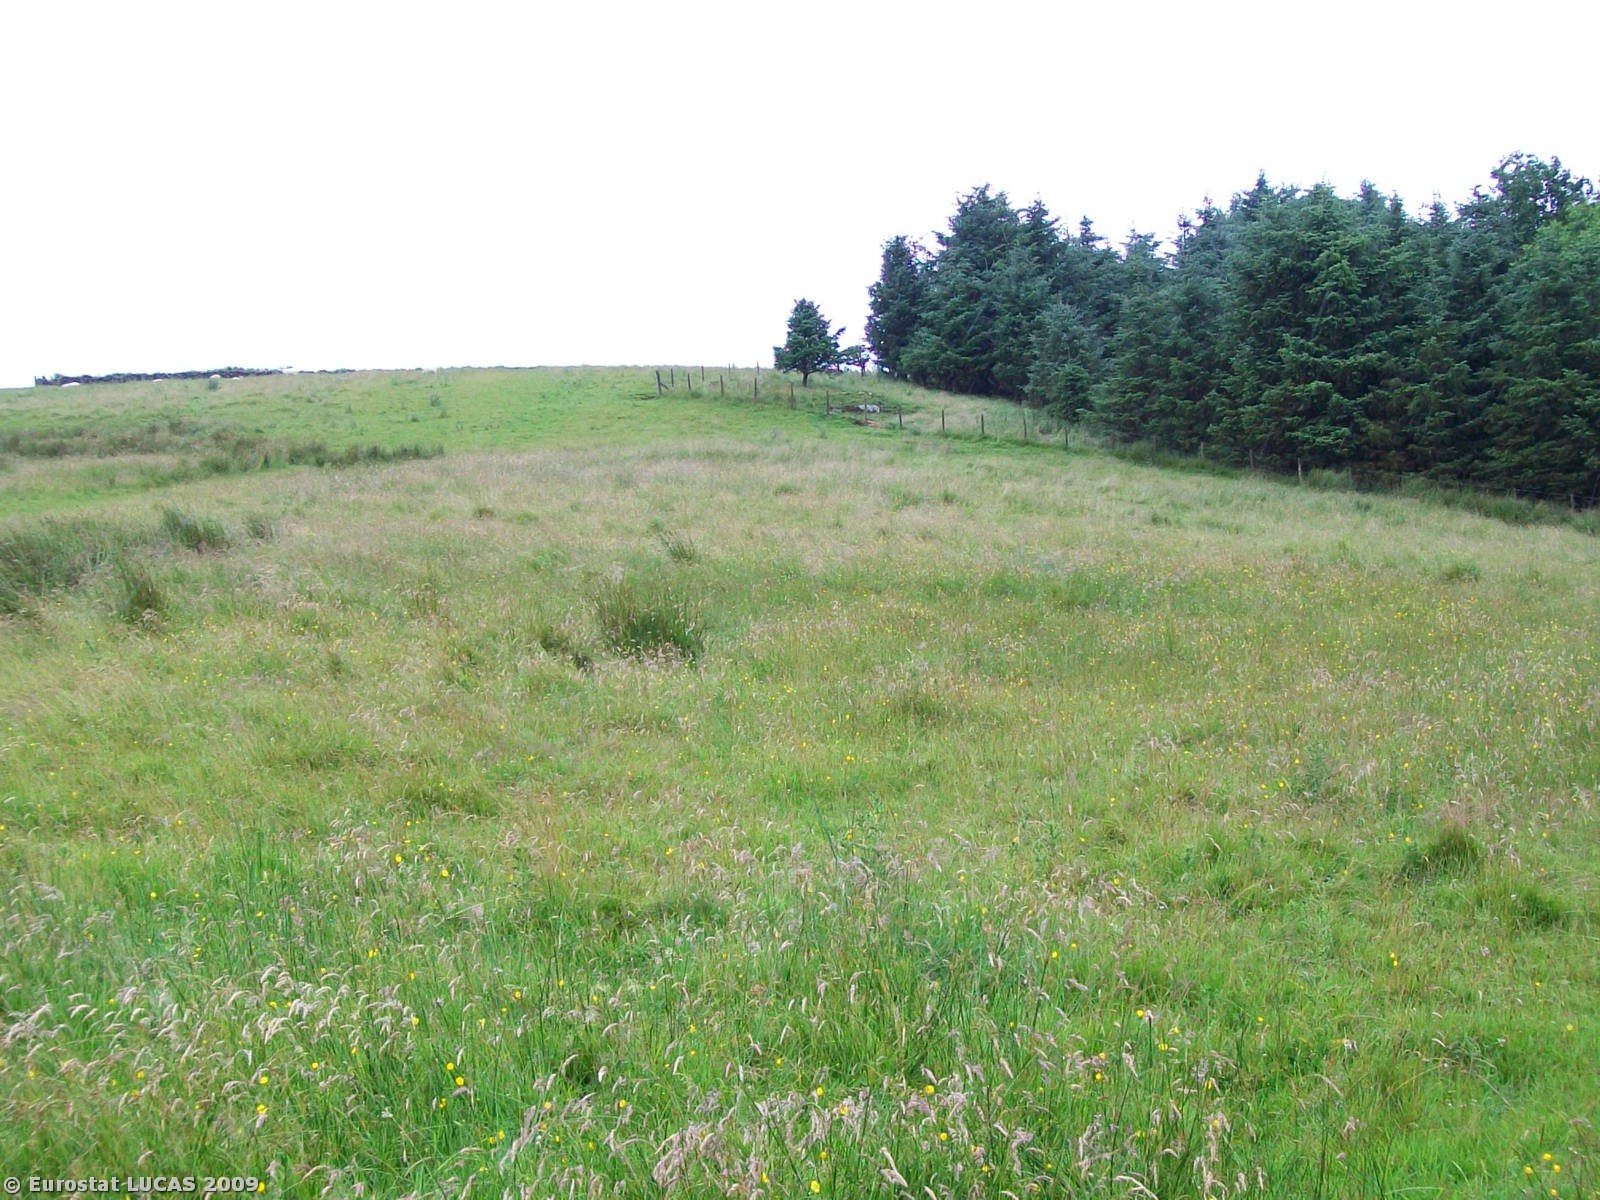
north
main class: Grassland
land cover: Grassland without tree/shrub cover
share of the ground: > 75 %
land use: Agriculture (excluding fallow land and kitchen gardens)
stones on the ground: < 10 %
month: July
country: GB
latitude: 55.2259
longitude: -2.1460
